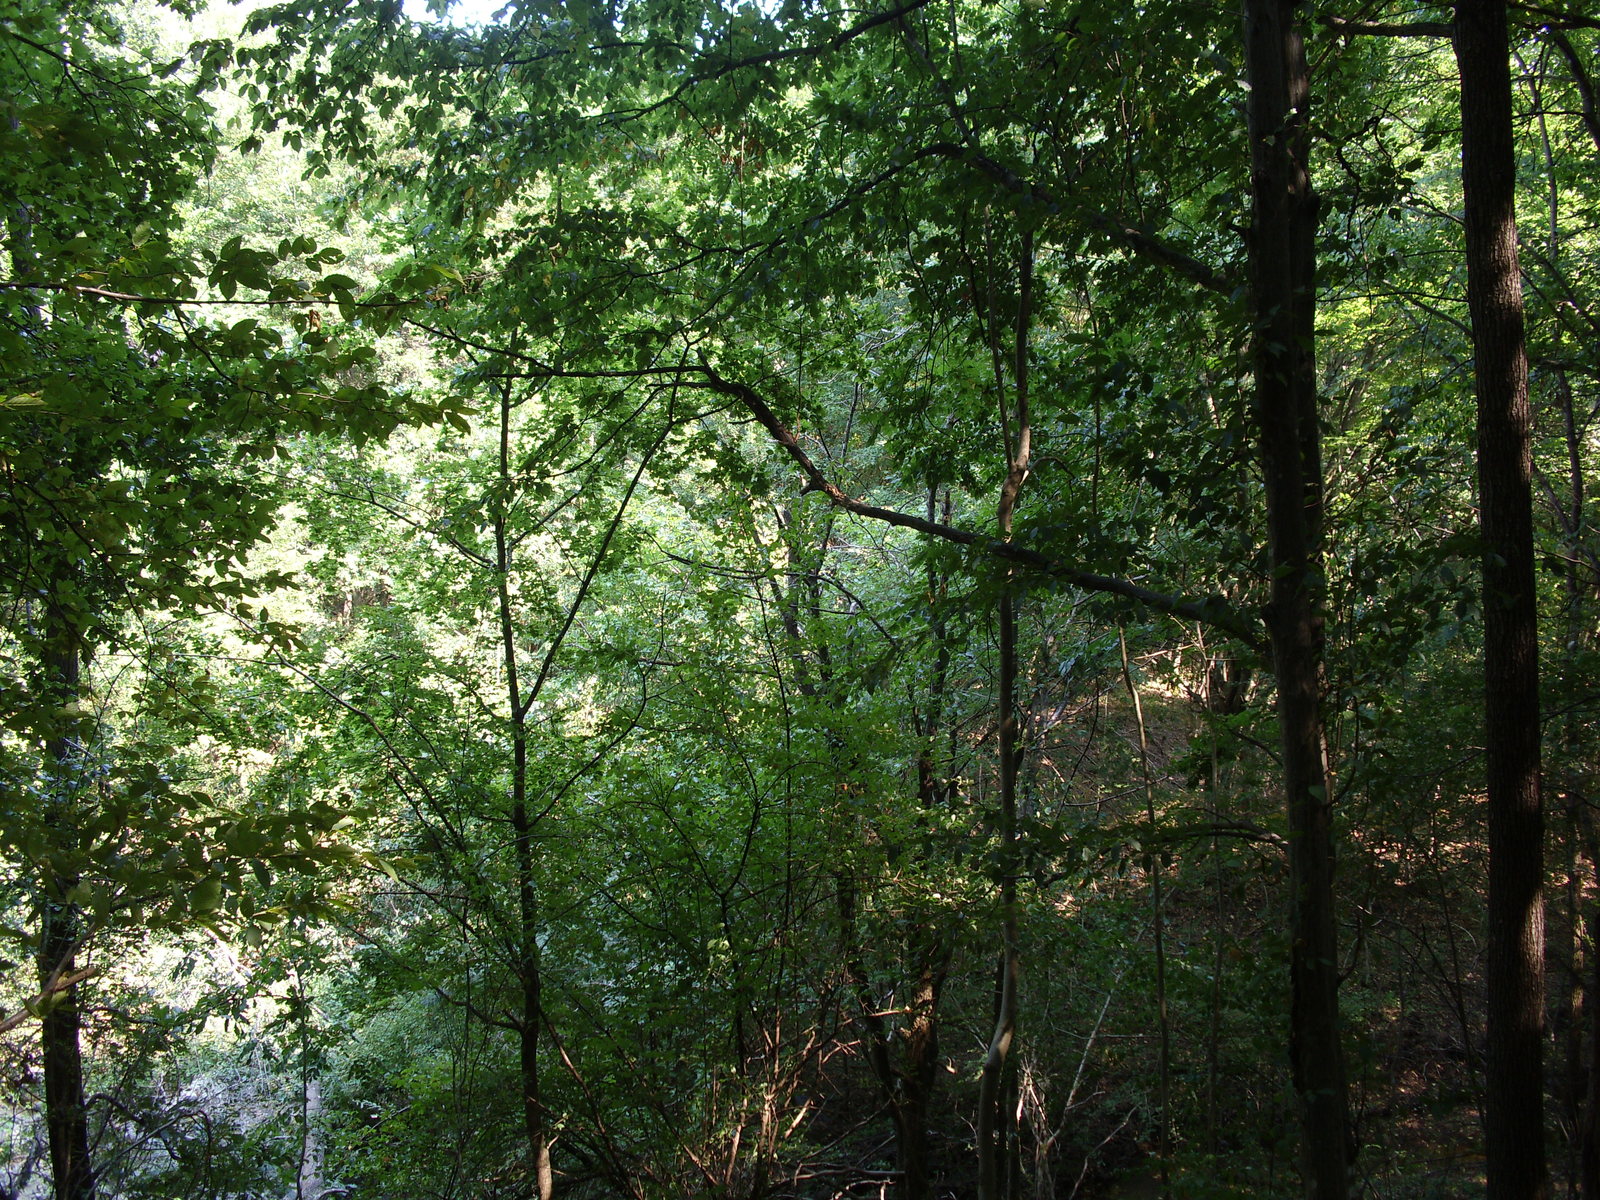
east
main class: Woodland
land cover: Broadleaved woodland
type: beech forest
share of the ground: > 75 %
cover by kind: broadleaved forest trees 95 %, shrubs 5 %
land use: Forestry
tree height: > 5 m
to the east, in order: Broadleaved woodland; Rivers and streams; Shrubland with sparse tree cover; Broadleaved woodland; Grass margins; Paved roads, cycling and walking lanes; Grass margins; Broadleaved woodland; Other mixed woodland
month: August
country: BG
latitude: 43.2679
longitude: 23.1836
